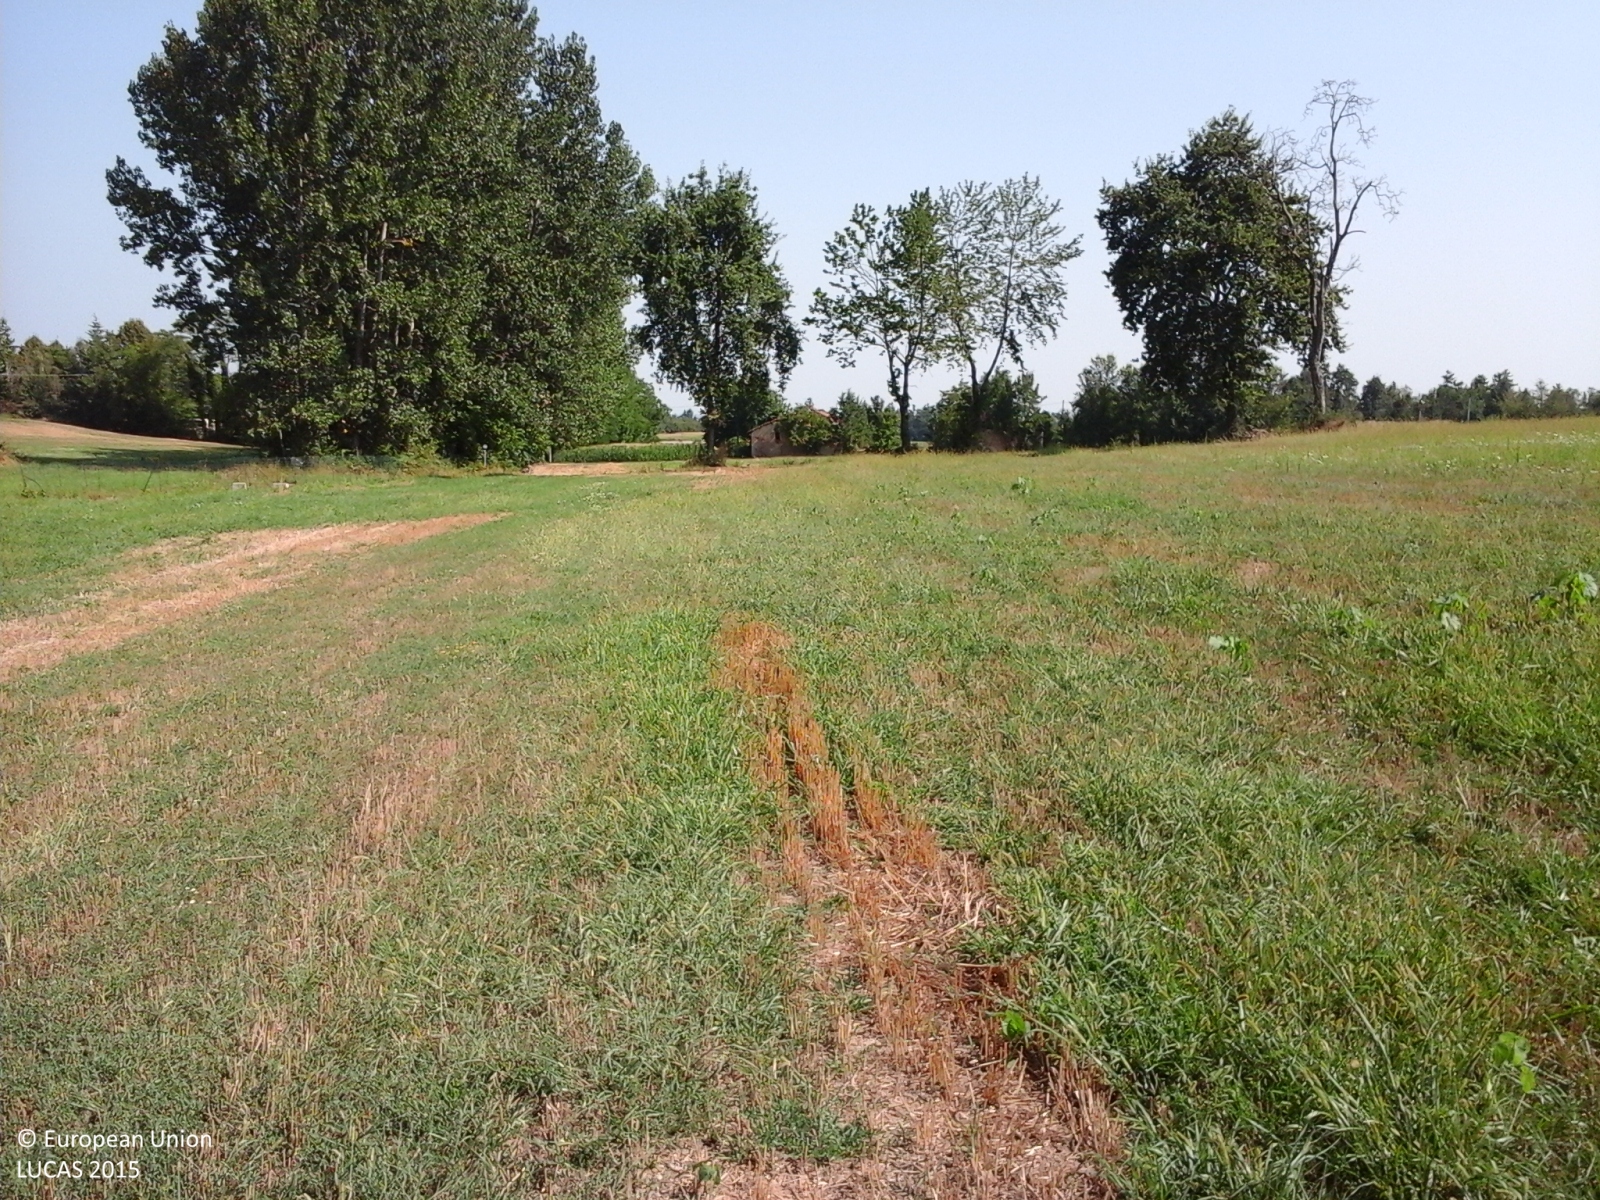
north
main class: Cropland
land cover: Common wheat
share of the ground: > 75 %
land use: Agriculture (excluding fallow land and kitchen gardens)
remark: Harvested field
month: August
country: IT
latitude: 44.3805
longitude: 7.7581
